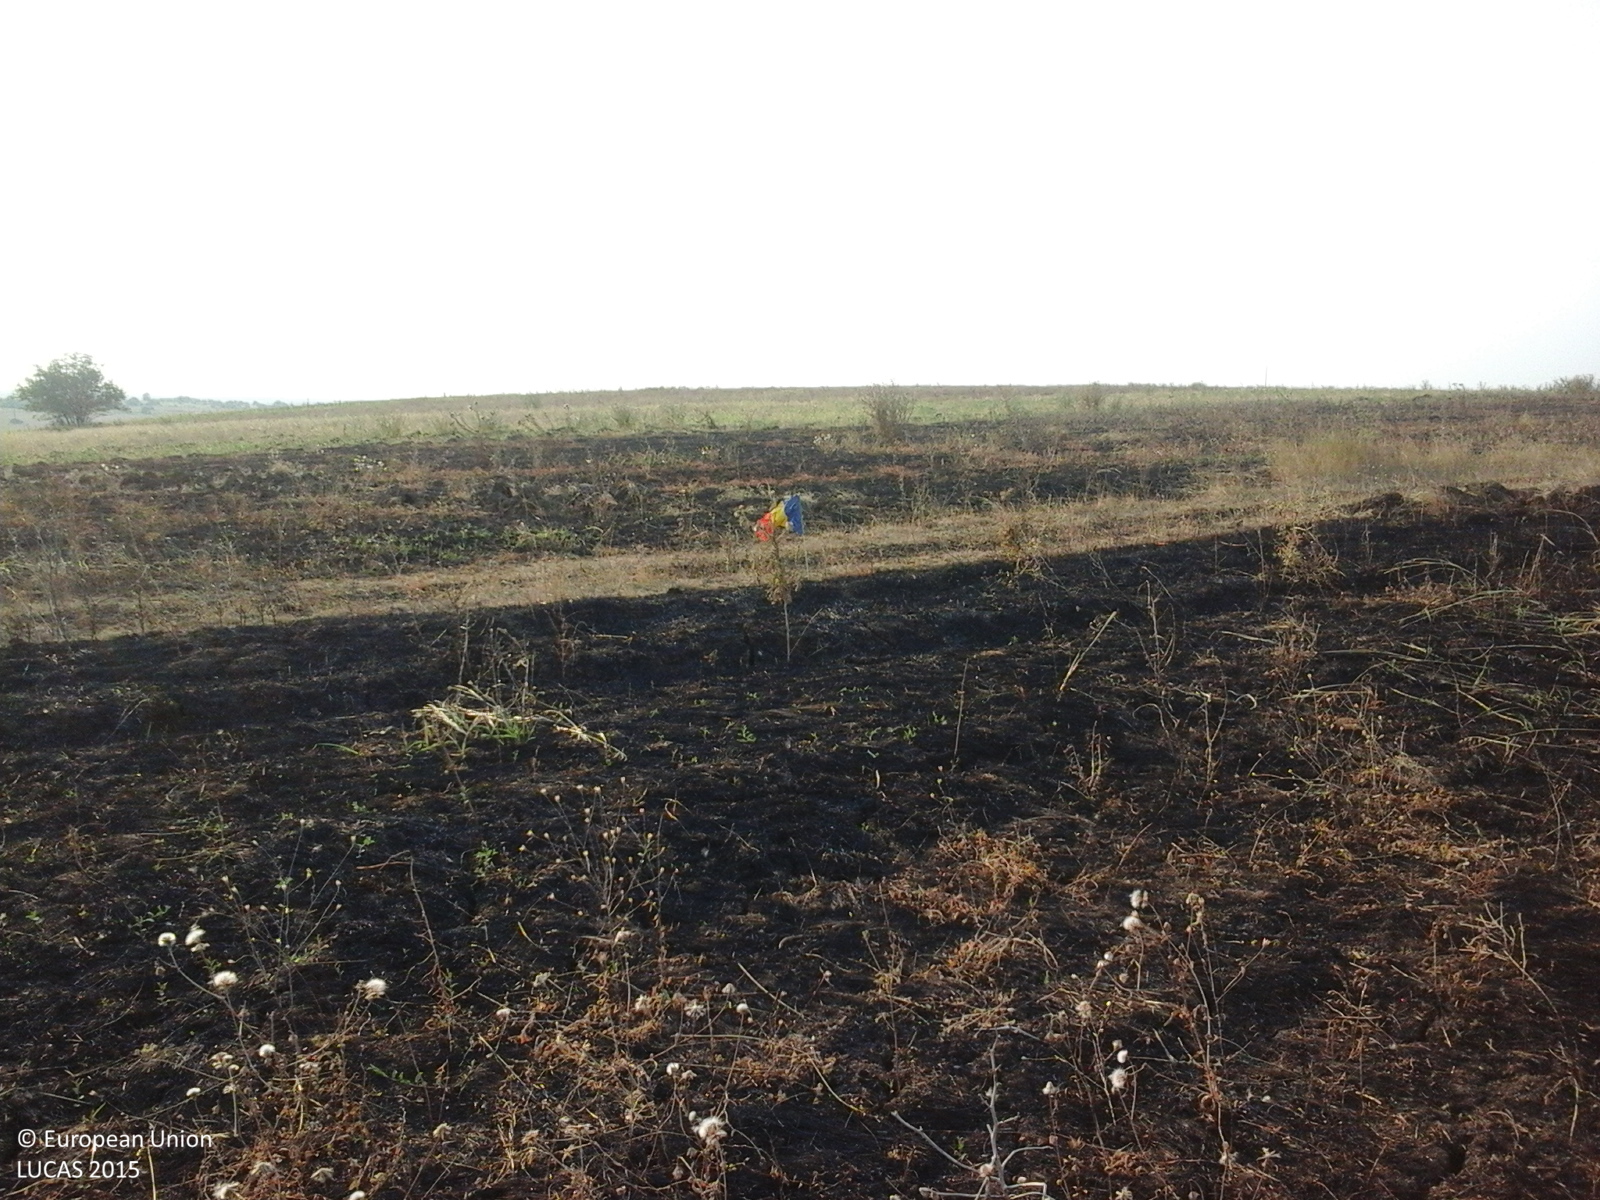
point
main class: Grassland
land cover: Spontaneously vegetated surfaces
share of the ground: > 75 %
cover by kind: herbaceous plants 100 %
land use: Fallow land
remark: Burnt area
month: August
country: RO
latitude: 44.2553
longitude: 23.5920
